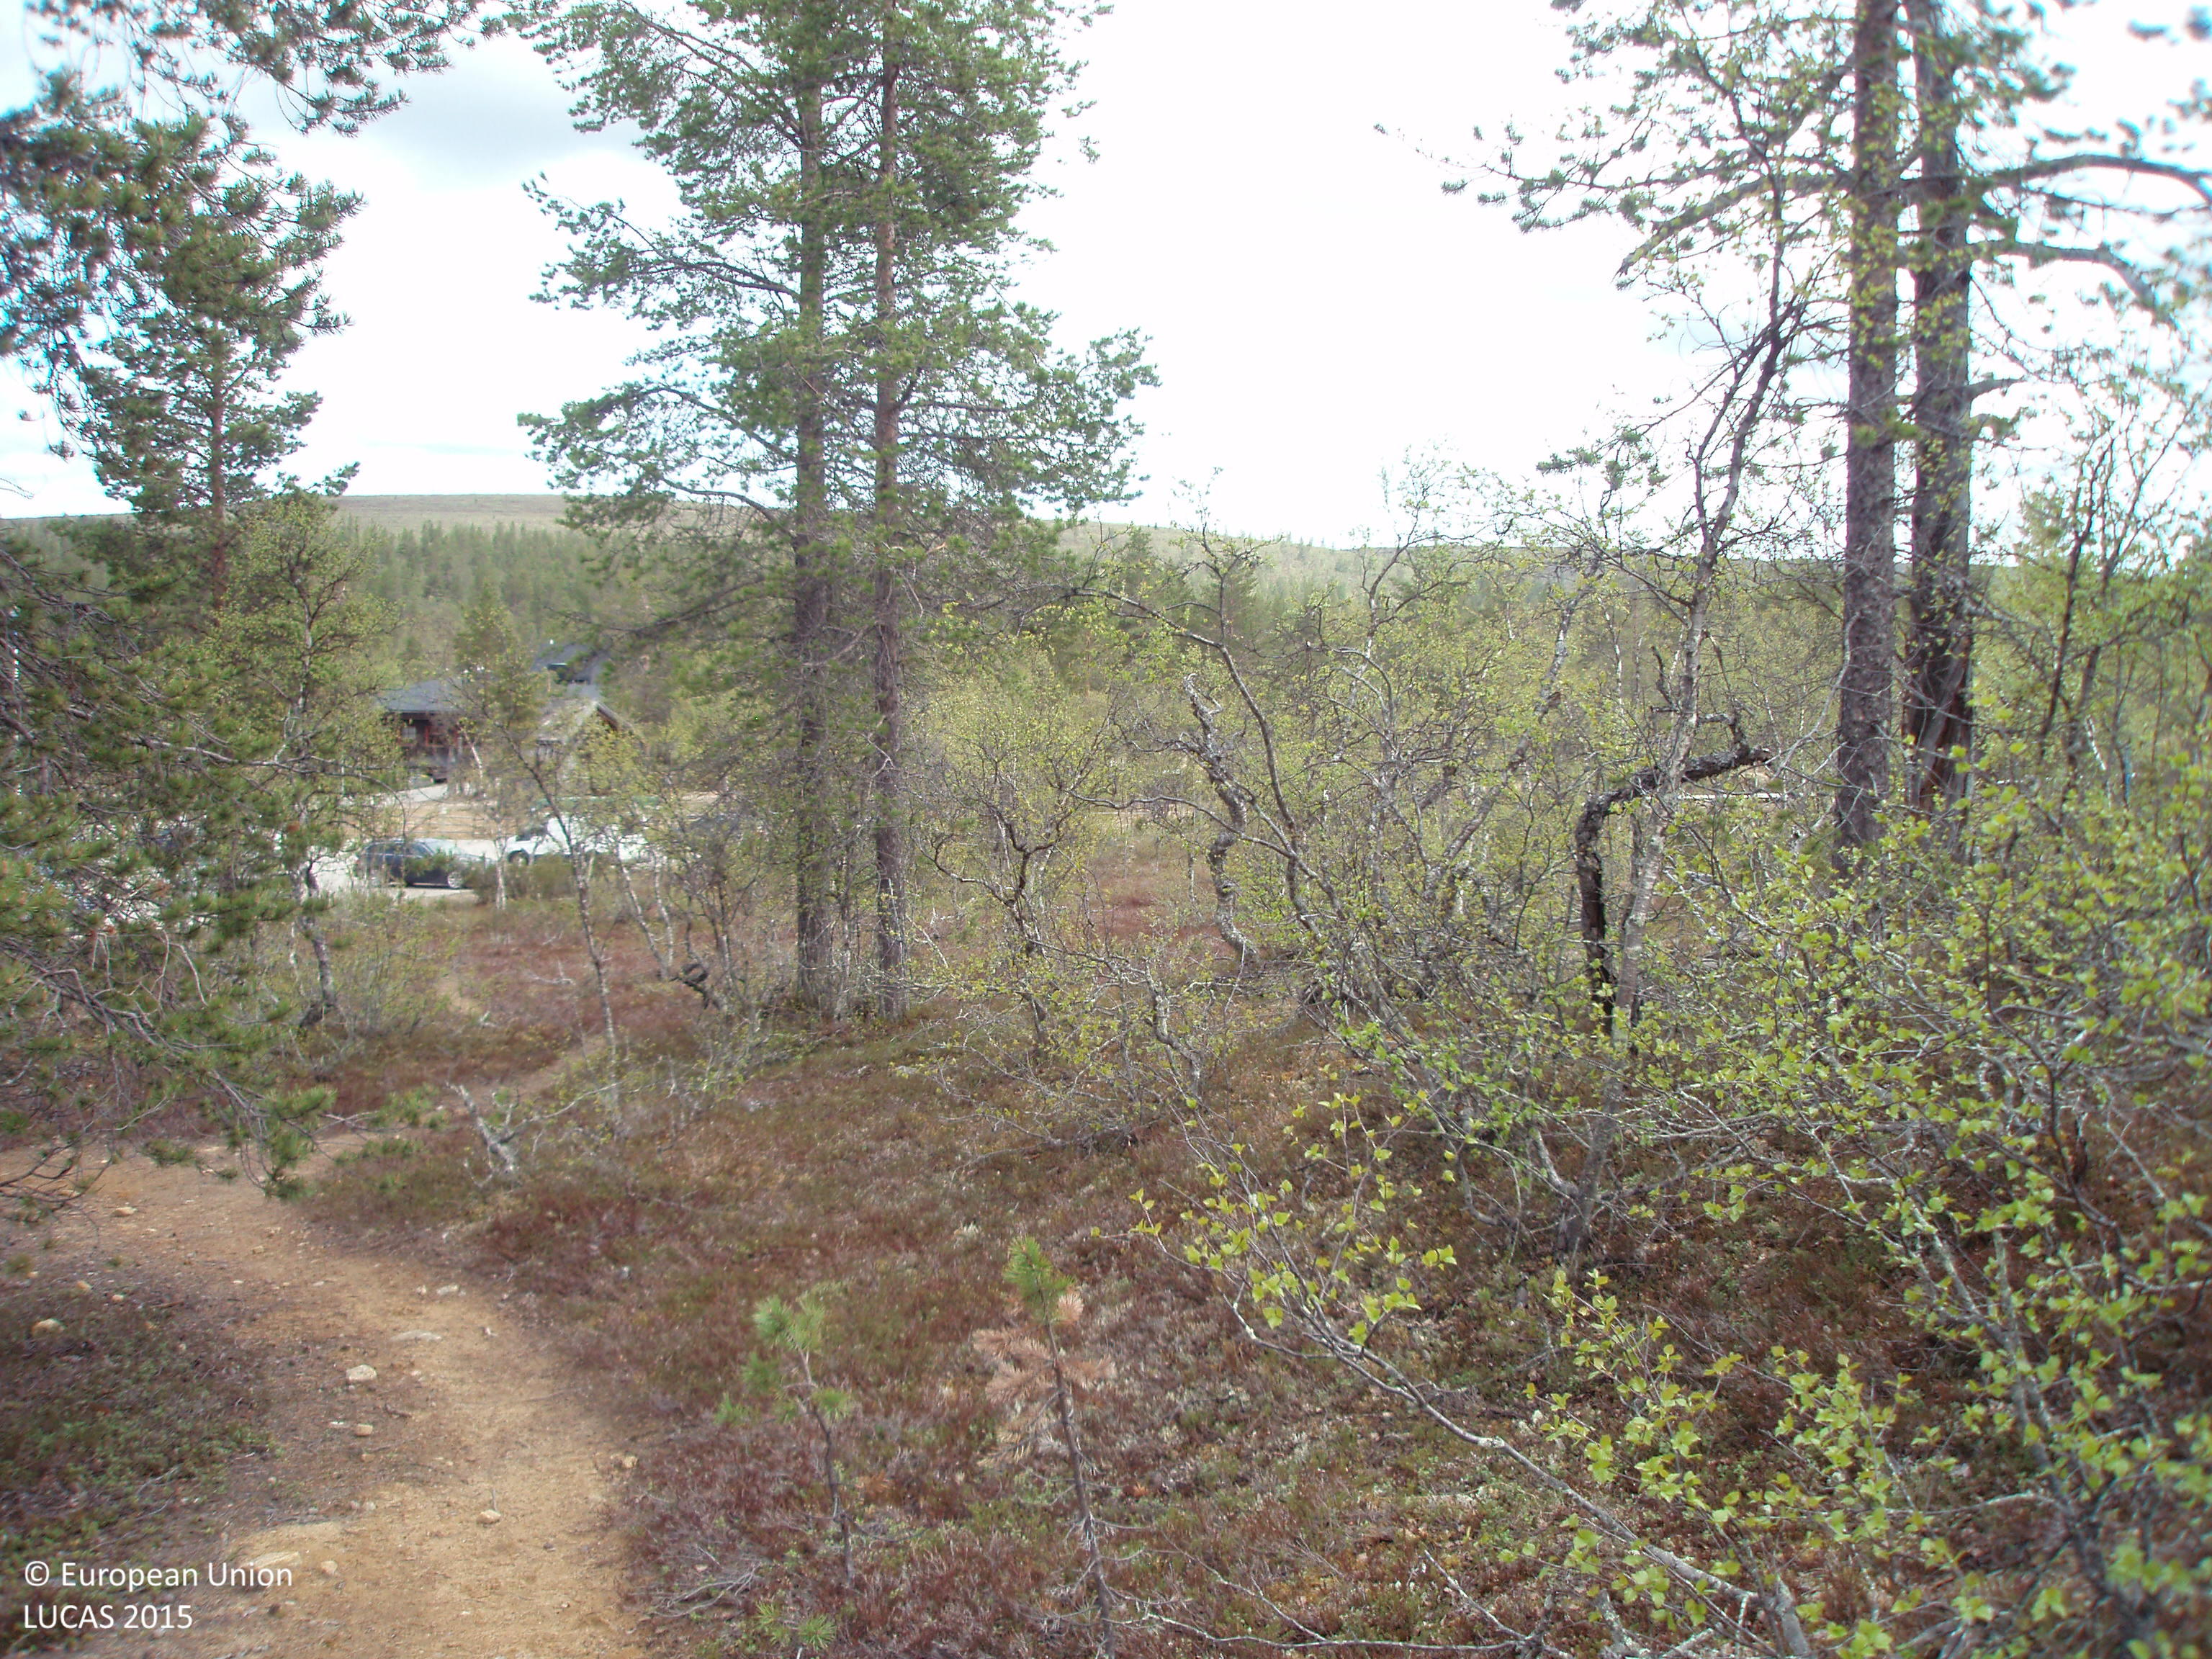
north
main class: Woodland
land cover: Other mixed woodland
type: boreal forest
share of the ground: > 75 %
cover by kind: broadleaved forest trees 55 %, shrubs 25 %, coniferous forest trees 20 %
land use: Amenities, museums, leisure
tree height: > 5 m
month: June
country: FI
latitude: 68.2093
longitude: 27.6880
